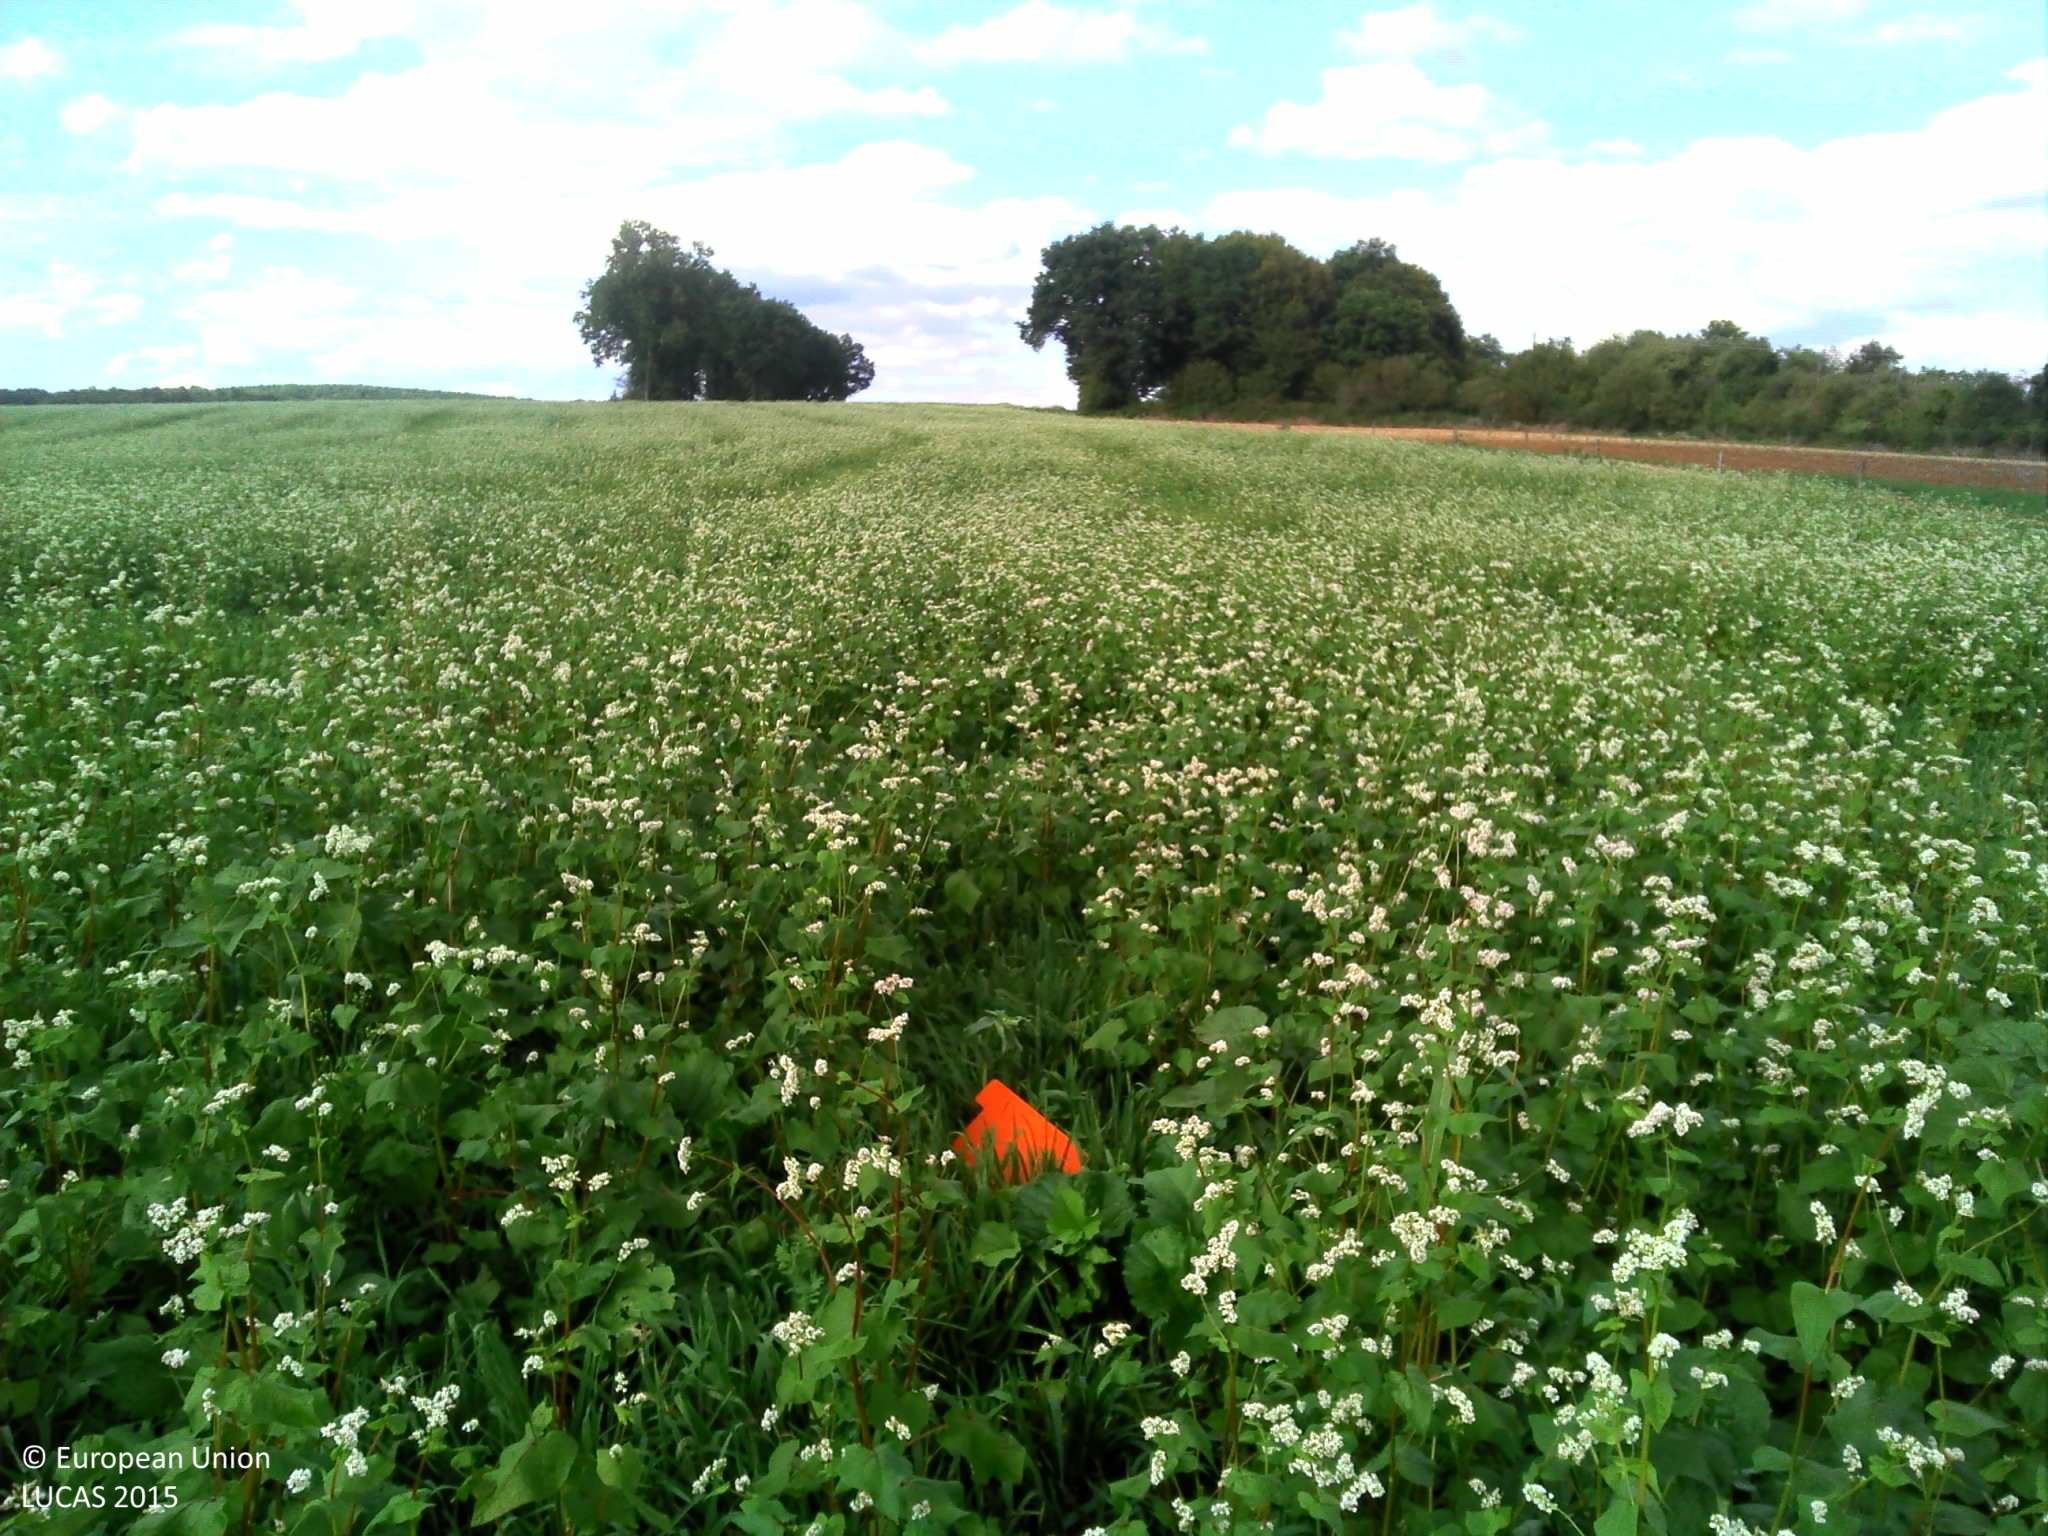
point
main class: Cropland
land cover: Other cereals
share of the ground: > 75 %
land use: Agriculture (excluding fallow land and kitchen gardens)
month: September
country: FR
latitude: 47.4067
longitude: 6.3574
